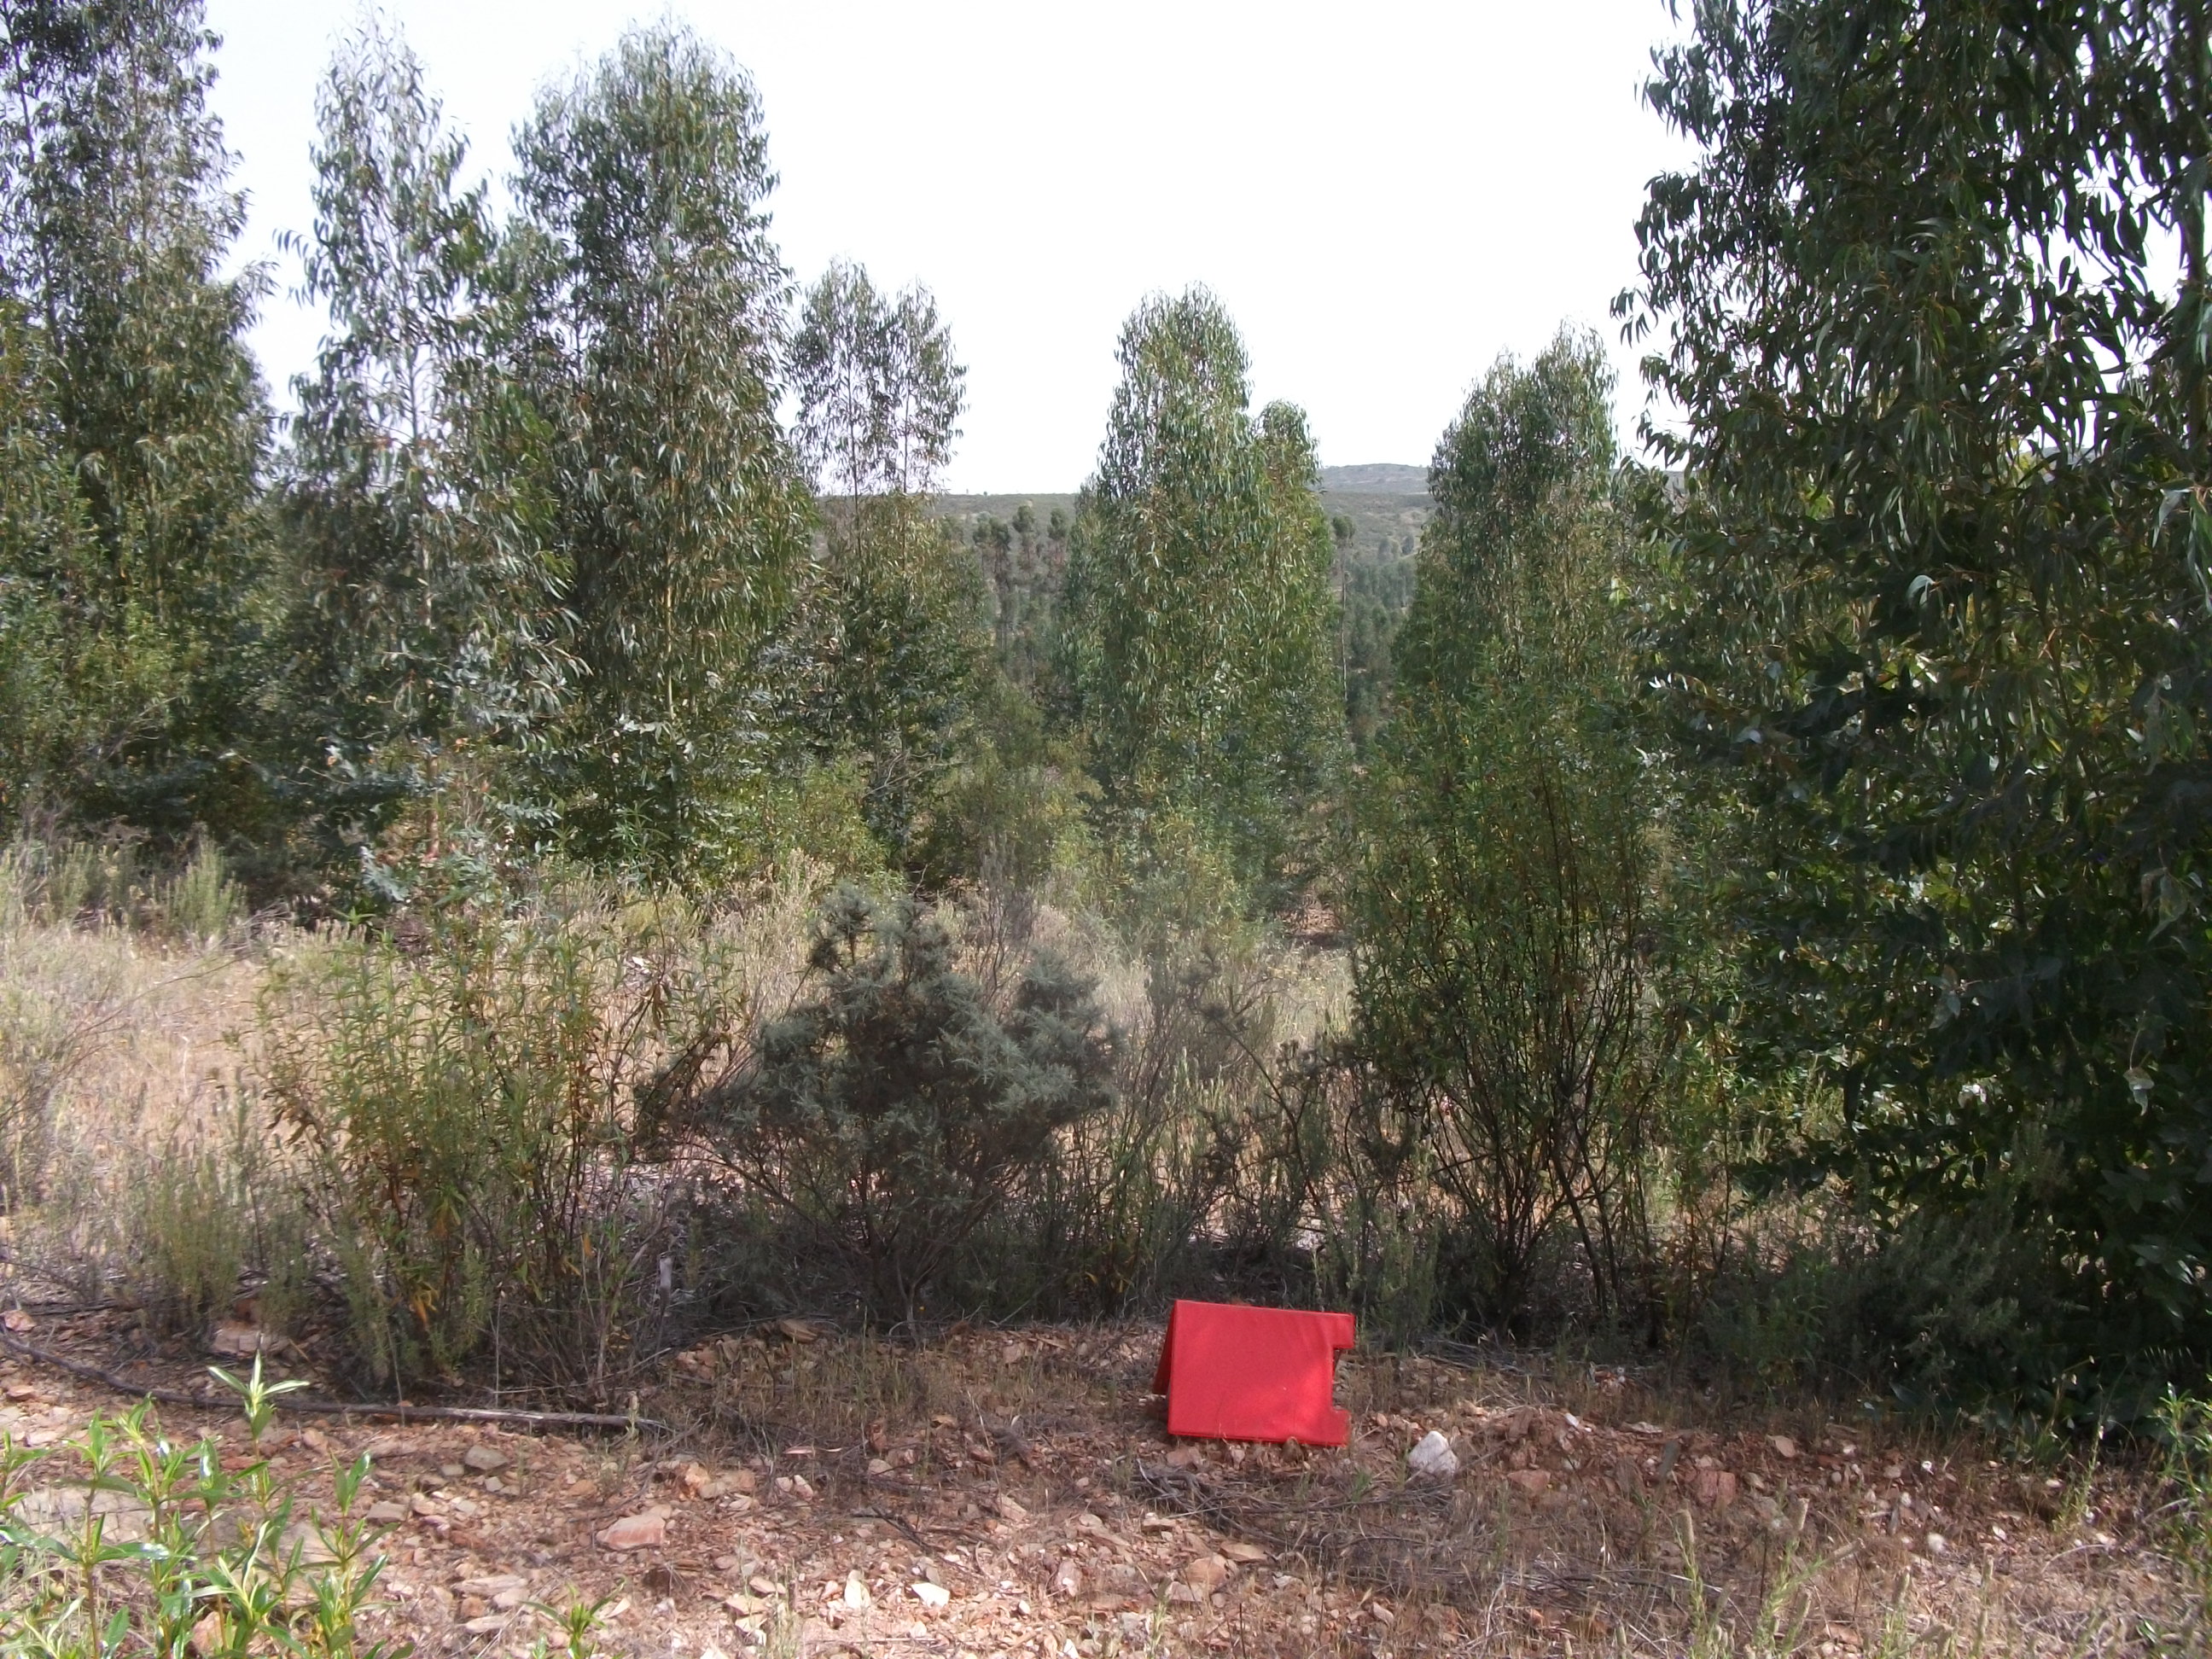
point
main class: Woodland
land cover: Broadleaved woodland
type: exotic forest
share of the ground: 50 - 75 %
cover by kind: broadleaved forest trees 60 %, shrubs 30 %, herbaceous plants 5 %, unconsolidated bare surface 5 %
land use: Forestry
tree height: > 5 m
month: May
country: ES
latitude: 37.7043
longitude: -6.9822
